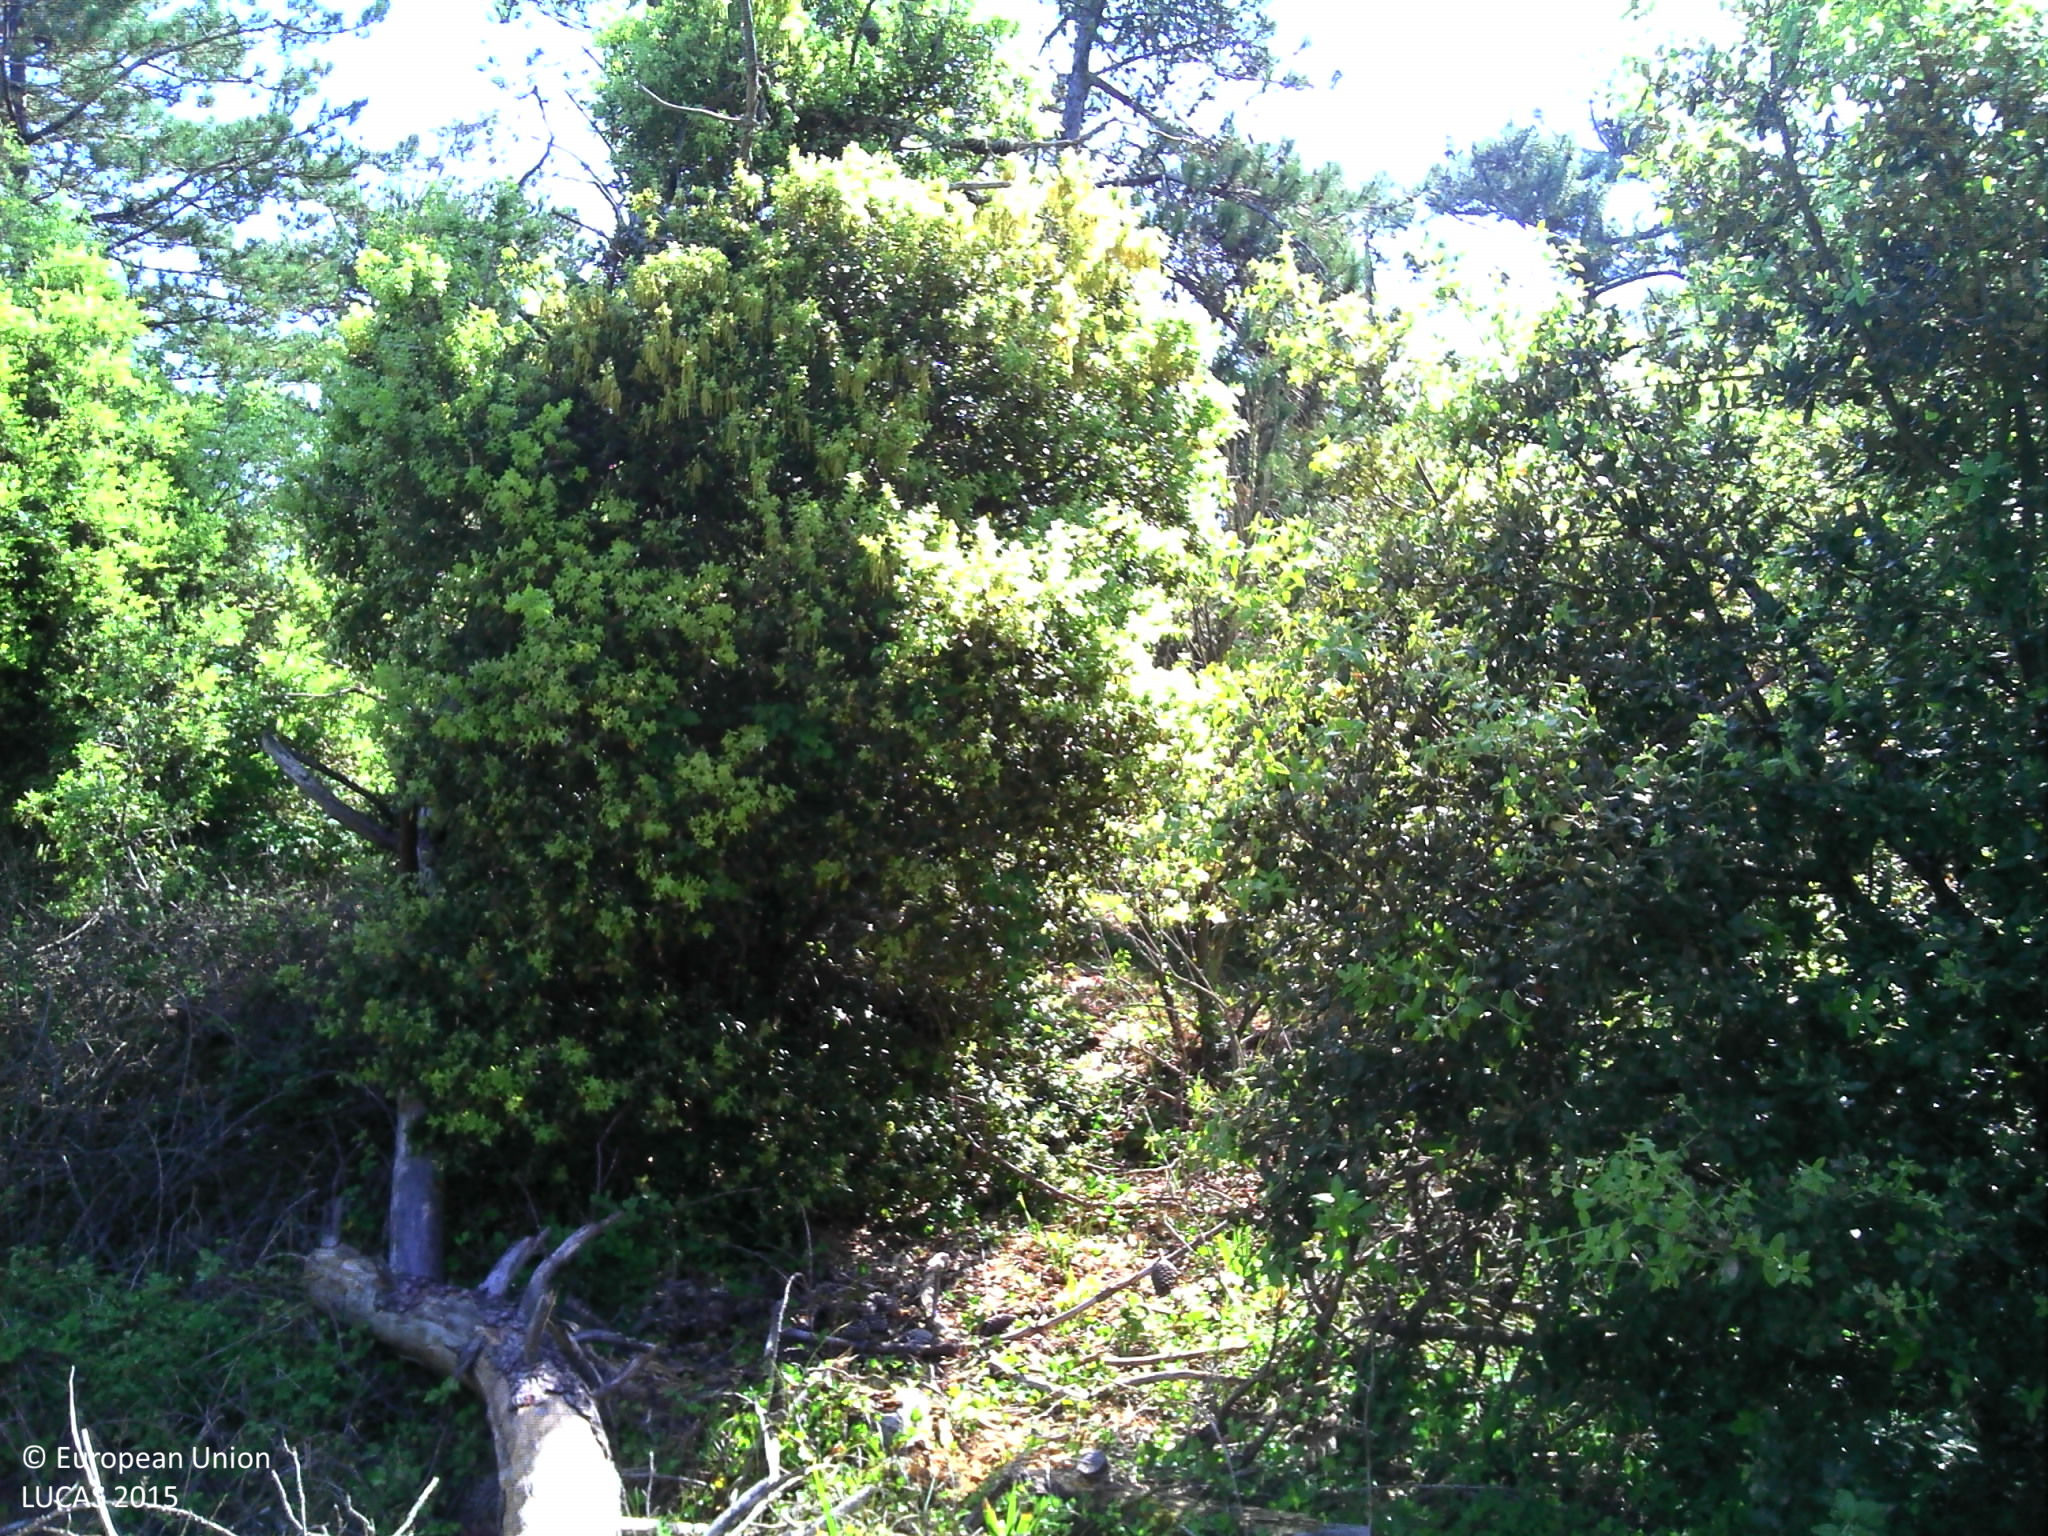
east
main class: Woodland
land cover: Pine dominated mixed woodland
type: coniferous forest of the mediterranean region
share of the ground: > 75 %
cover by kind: coniferous forest trees 75 %, broadleaved forest trees 25 %
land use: Forestry
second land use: Agriculture (excluding fallow land and kitchen gardens)
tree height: > 5 m
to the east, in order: Pine dominated mixed woodland; Paved roads, cycling and walking lanes; Pine dominated mixed woodland
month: May
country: FR
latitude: 46.2542
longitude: -1.5169
